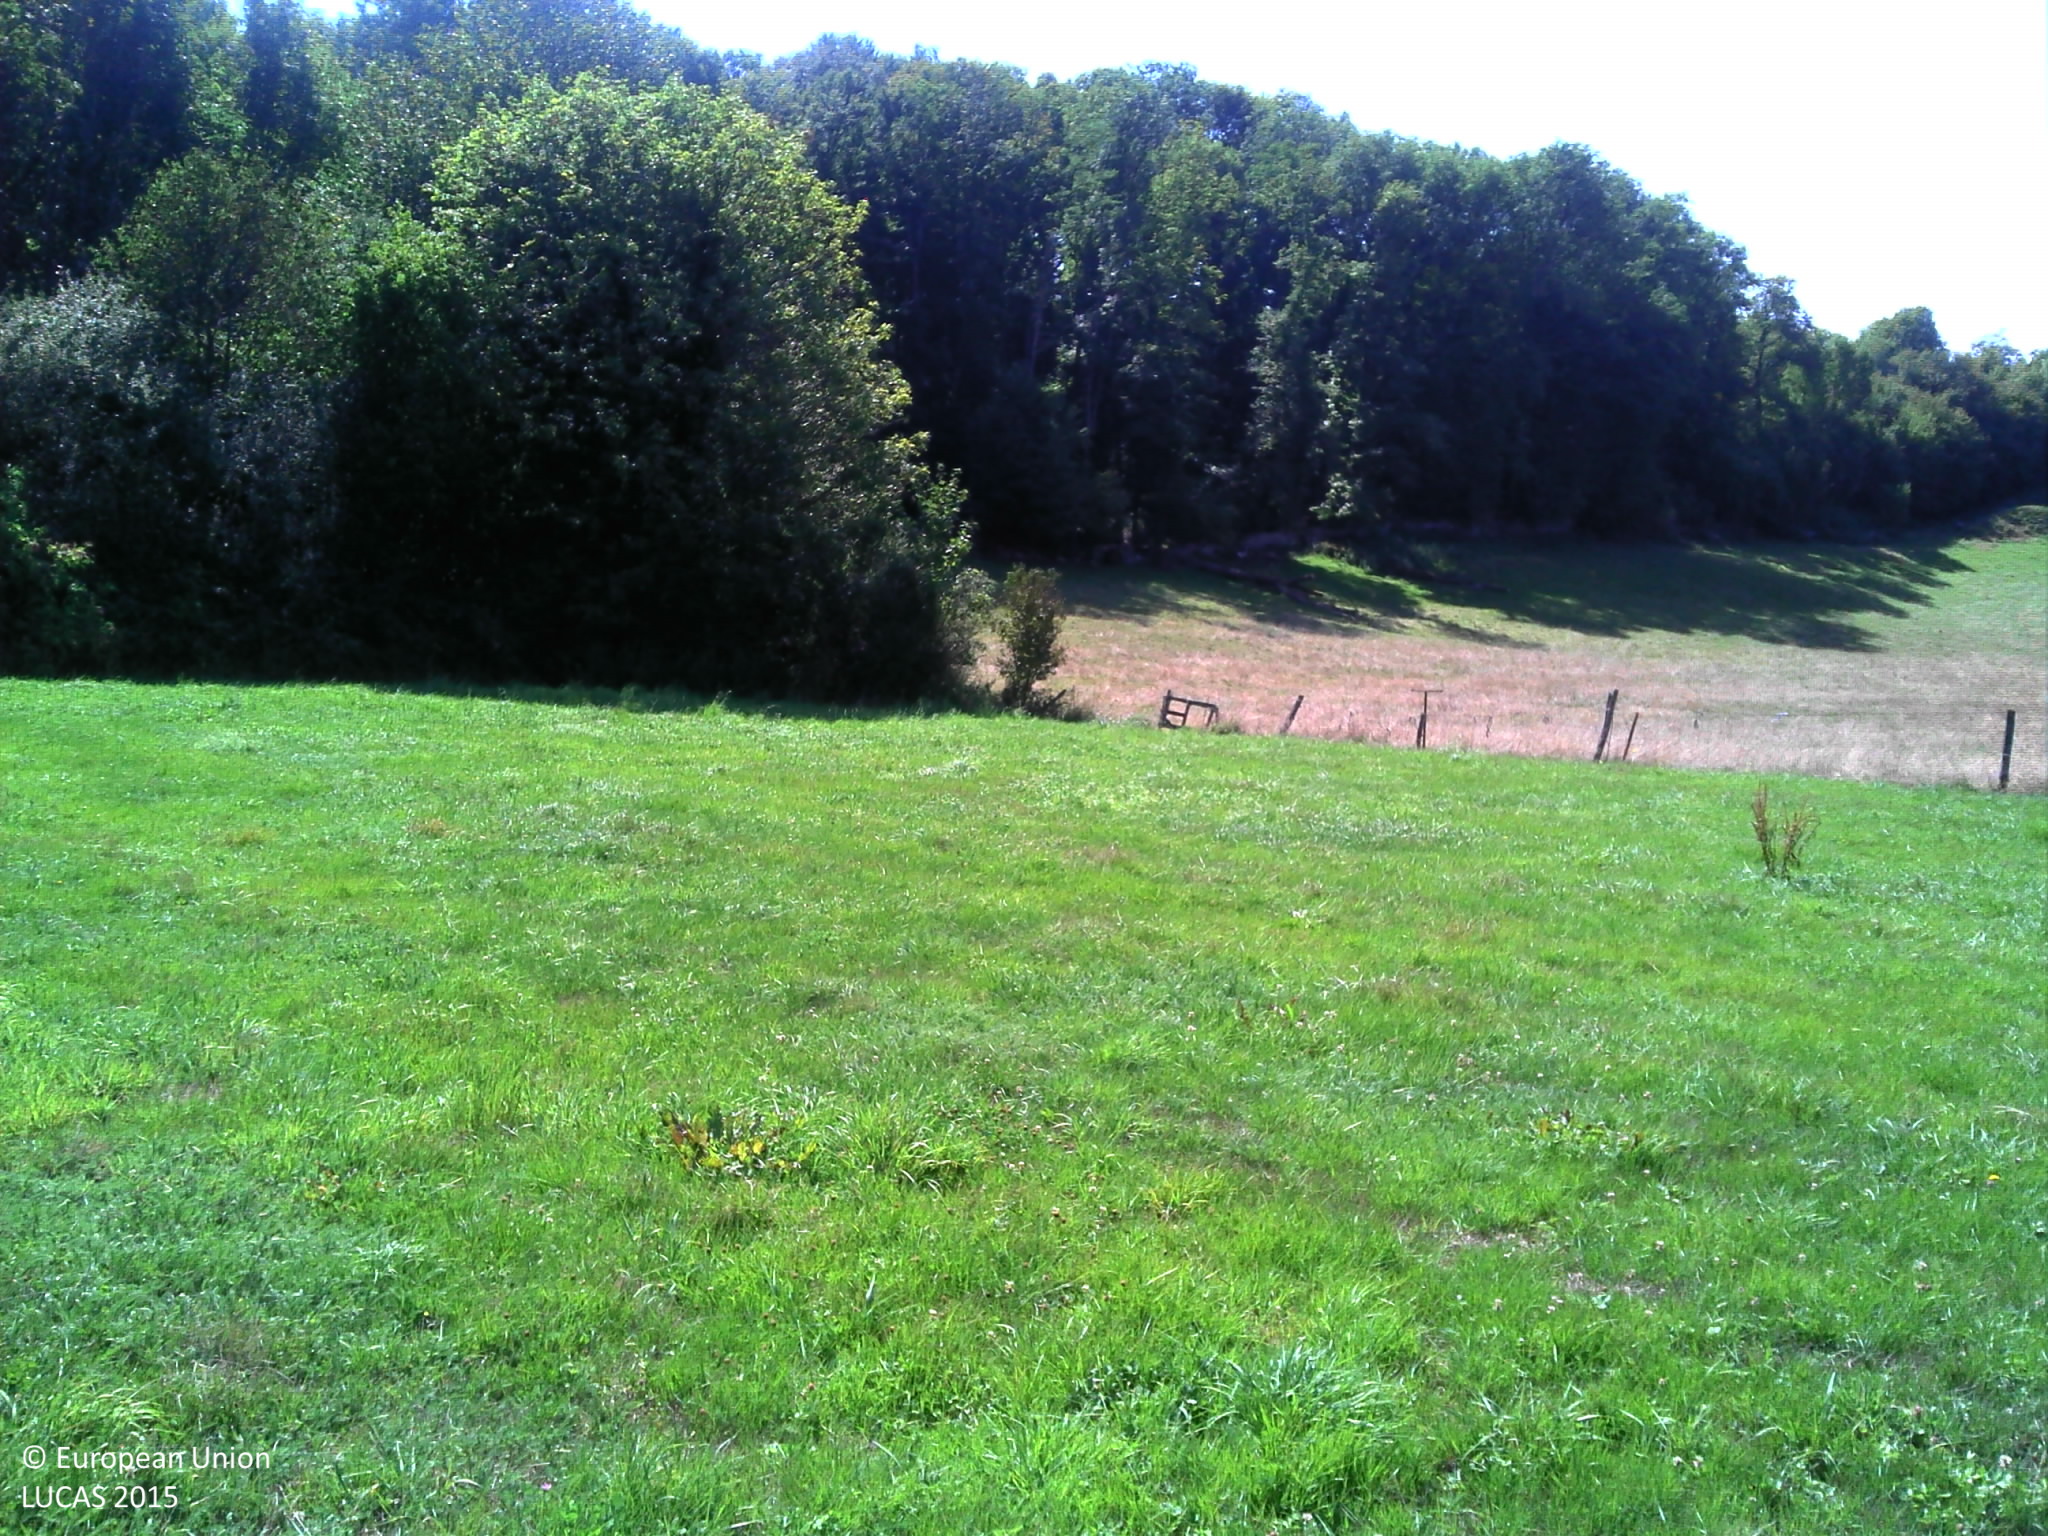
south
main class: Grassland
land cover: Grassland without tree/shrub cover
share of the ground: > 75 %
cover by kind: herbaceous plants 100 %
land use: Agriculture (excluding fallow land and kitchen gardens)
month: September
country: FR
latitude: 47.2868
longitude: 6.0219
